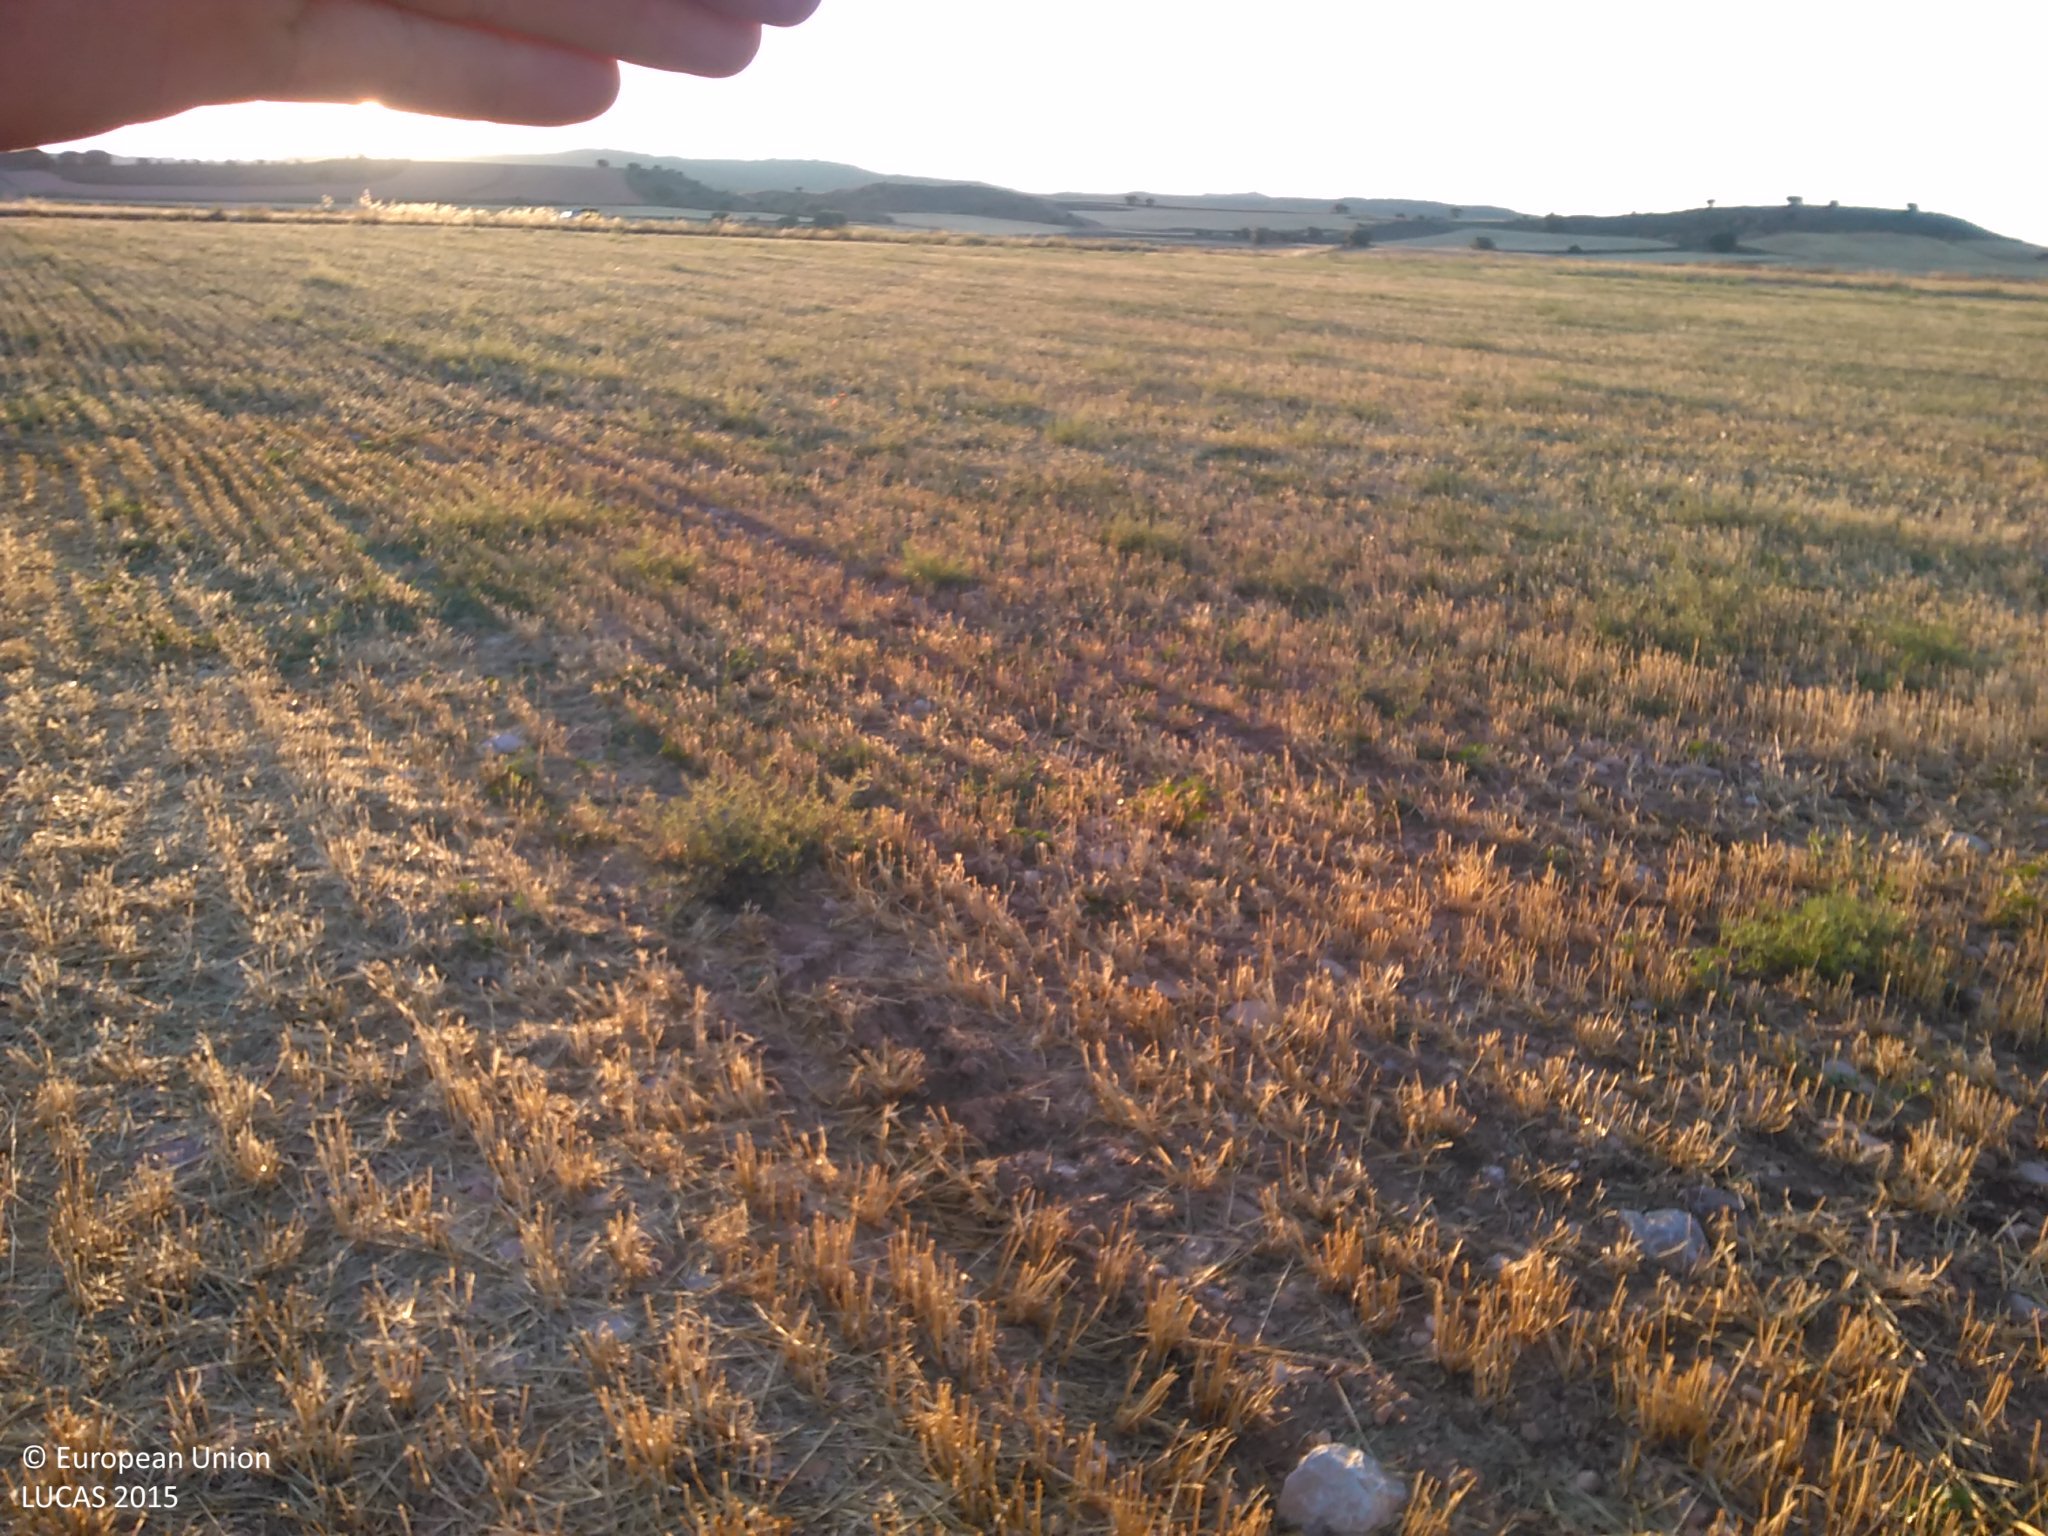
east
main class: Cropland
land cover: Barley
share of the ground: < 10 %
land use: Agriculture (excluding fallow land and kitchen gardens)
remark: Harvested field
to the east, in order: Barley; Grass margins; Tracks; Grass margins; Barley; Grass margins; Tracks; Grass margins; Barley; Grass margins; Barley
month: July
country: ES
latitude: 41.4652
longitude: -2.1360
